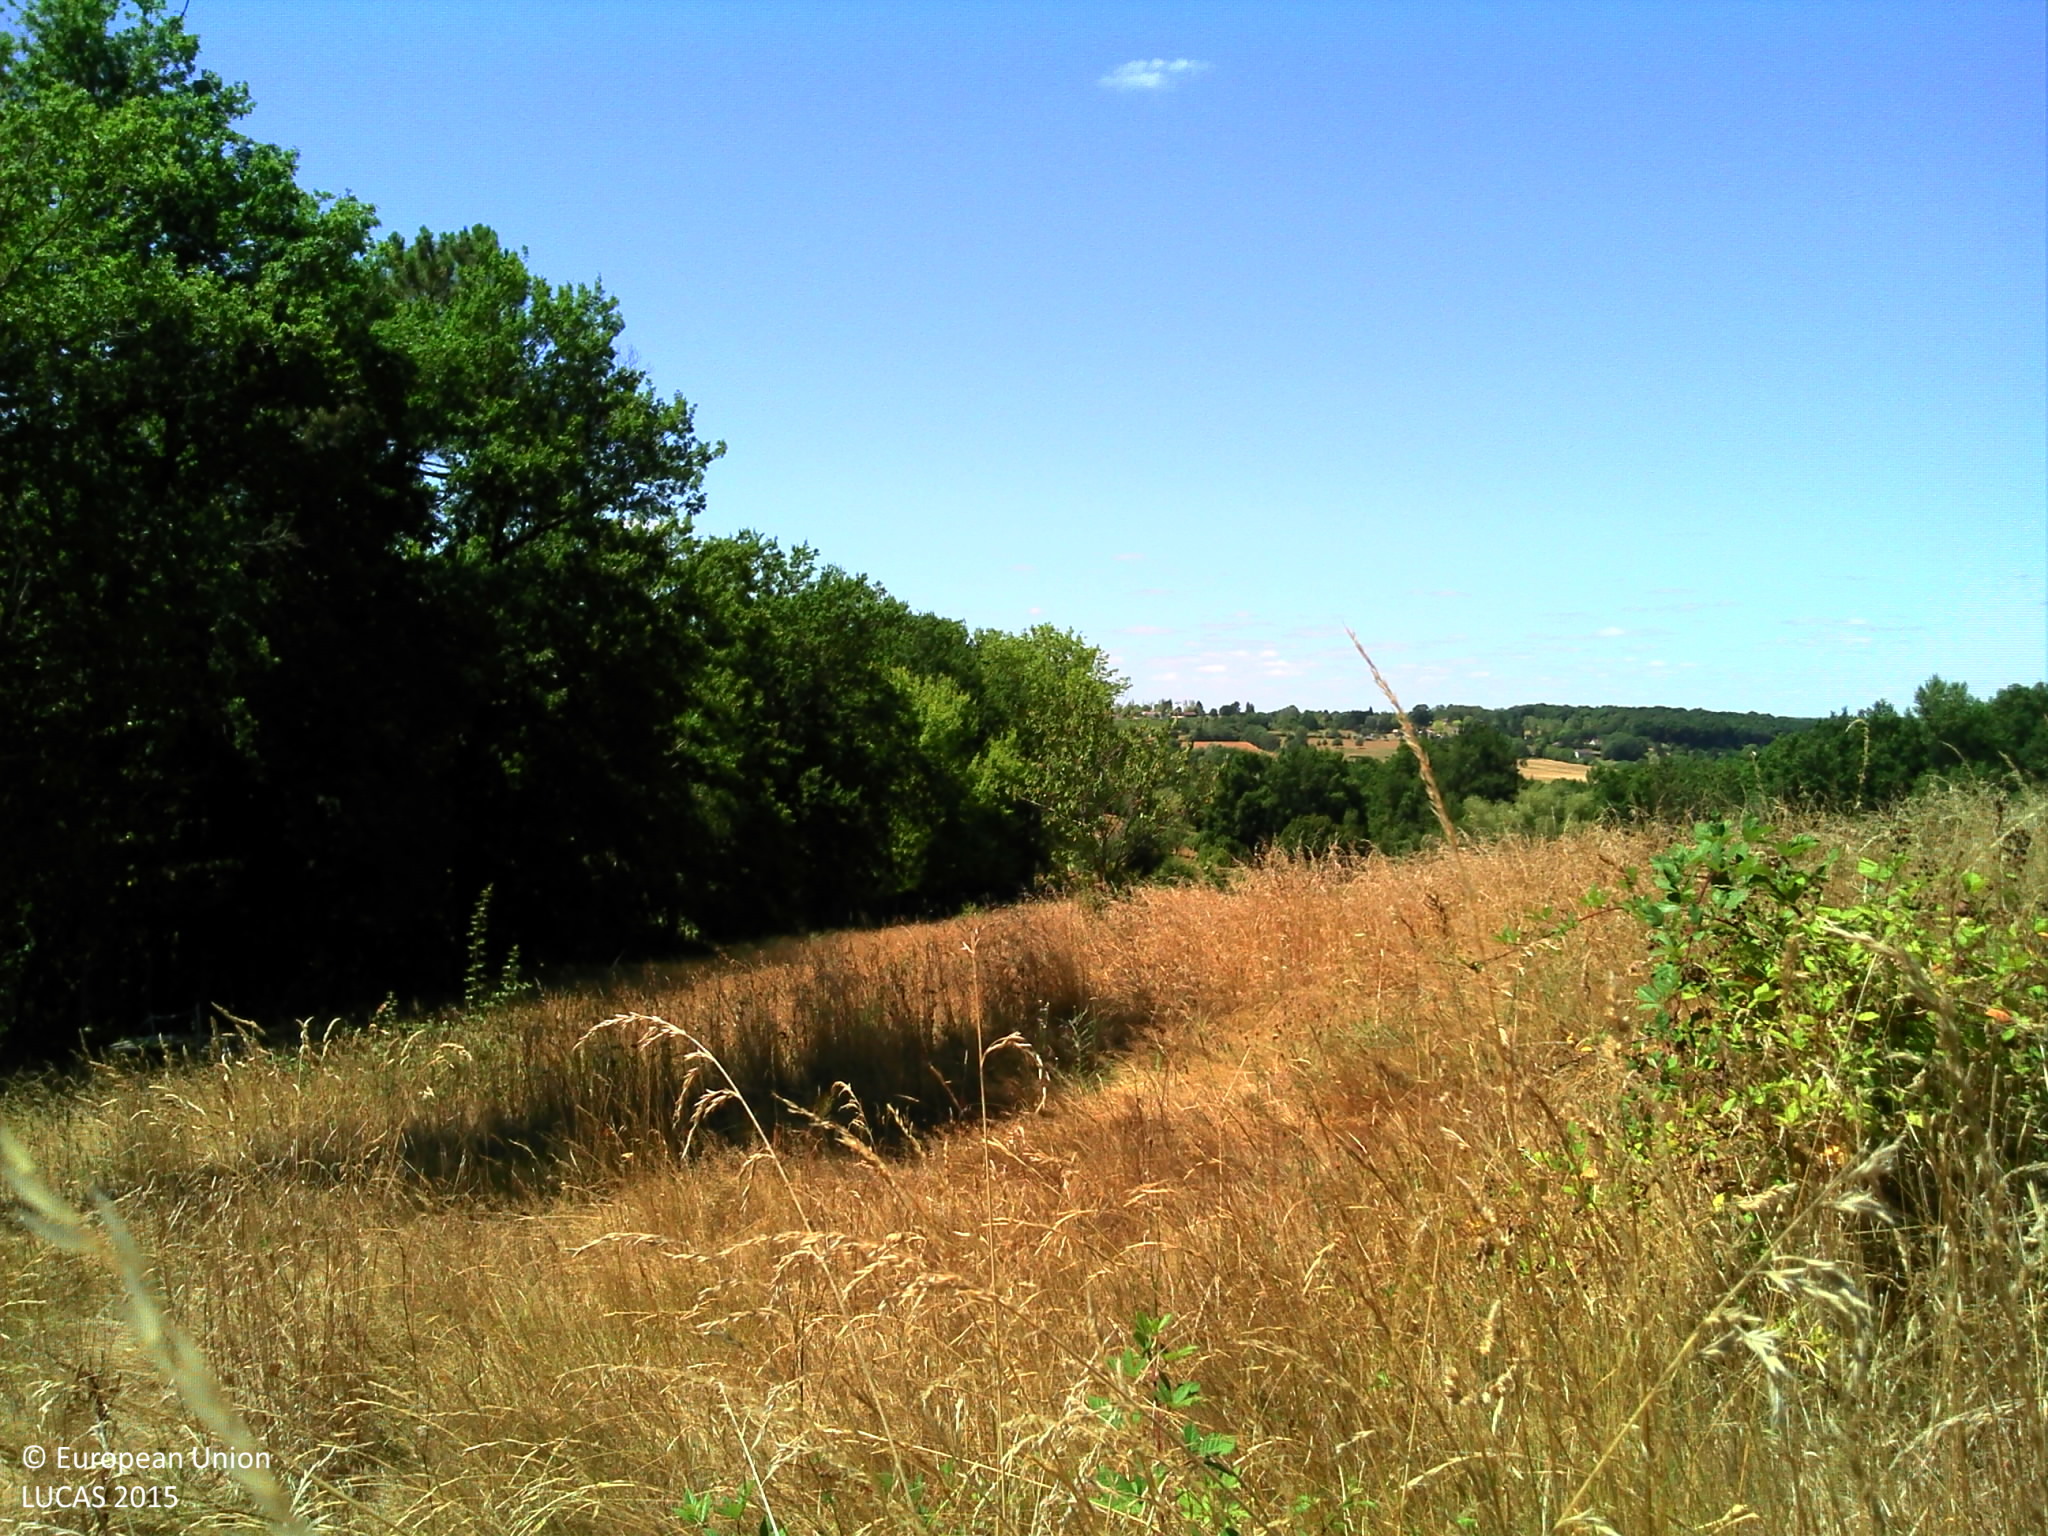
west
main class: Grassland
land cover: Grassland with sparse tree/shrub cover
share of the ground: > 75 %
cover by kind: herbaceous plants 95 %, broadleaved forest trees 5 %
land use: Agriculture (excluding fallow land and kitchen gardens)
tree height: < 5 m
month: July
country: FR
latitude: 44.8095
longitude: 0.5712
